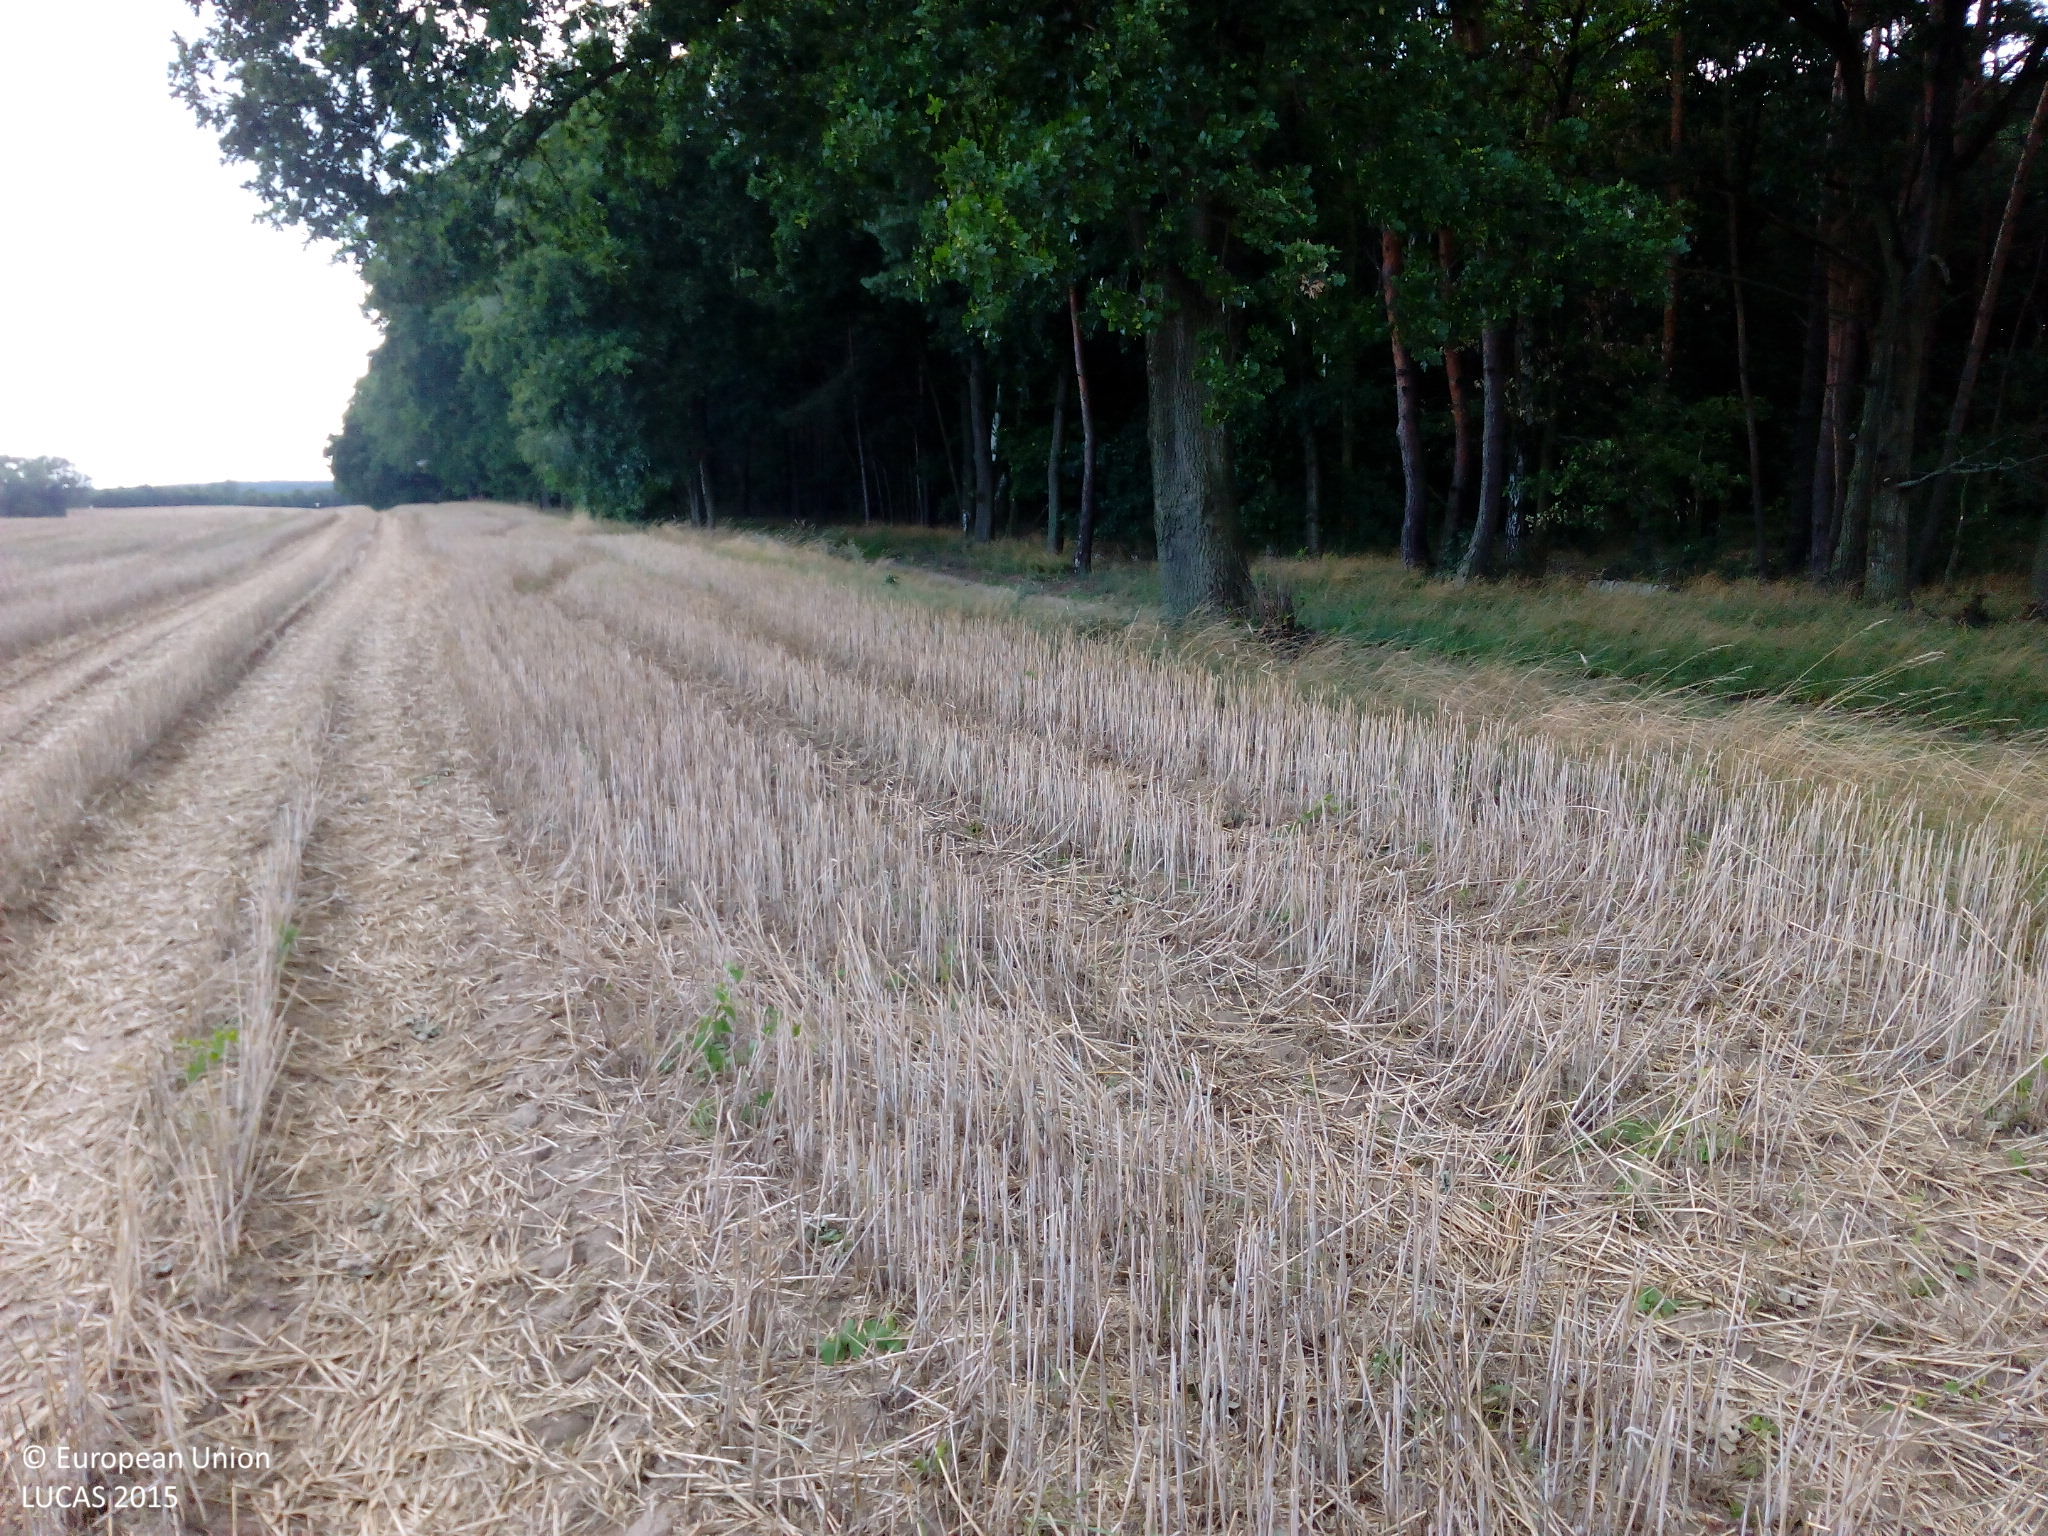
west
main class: Cropland
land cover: Rye
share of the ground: > 75 %
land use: Agriculture (excluding fallow land and kitchen gardens)
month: July
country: DE
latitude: 52.2173
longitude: 14.0847
